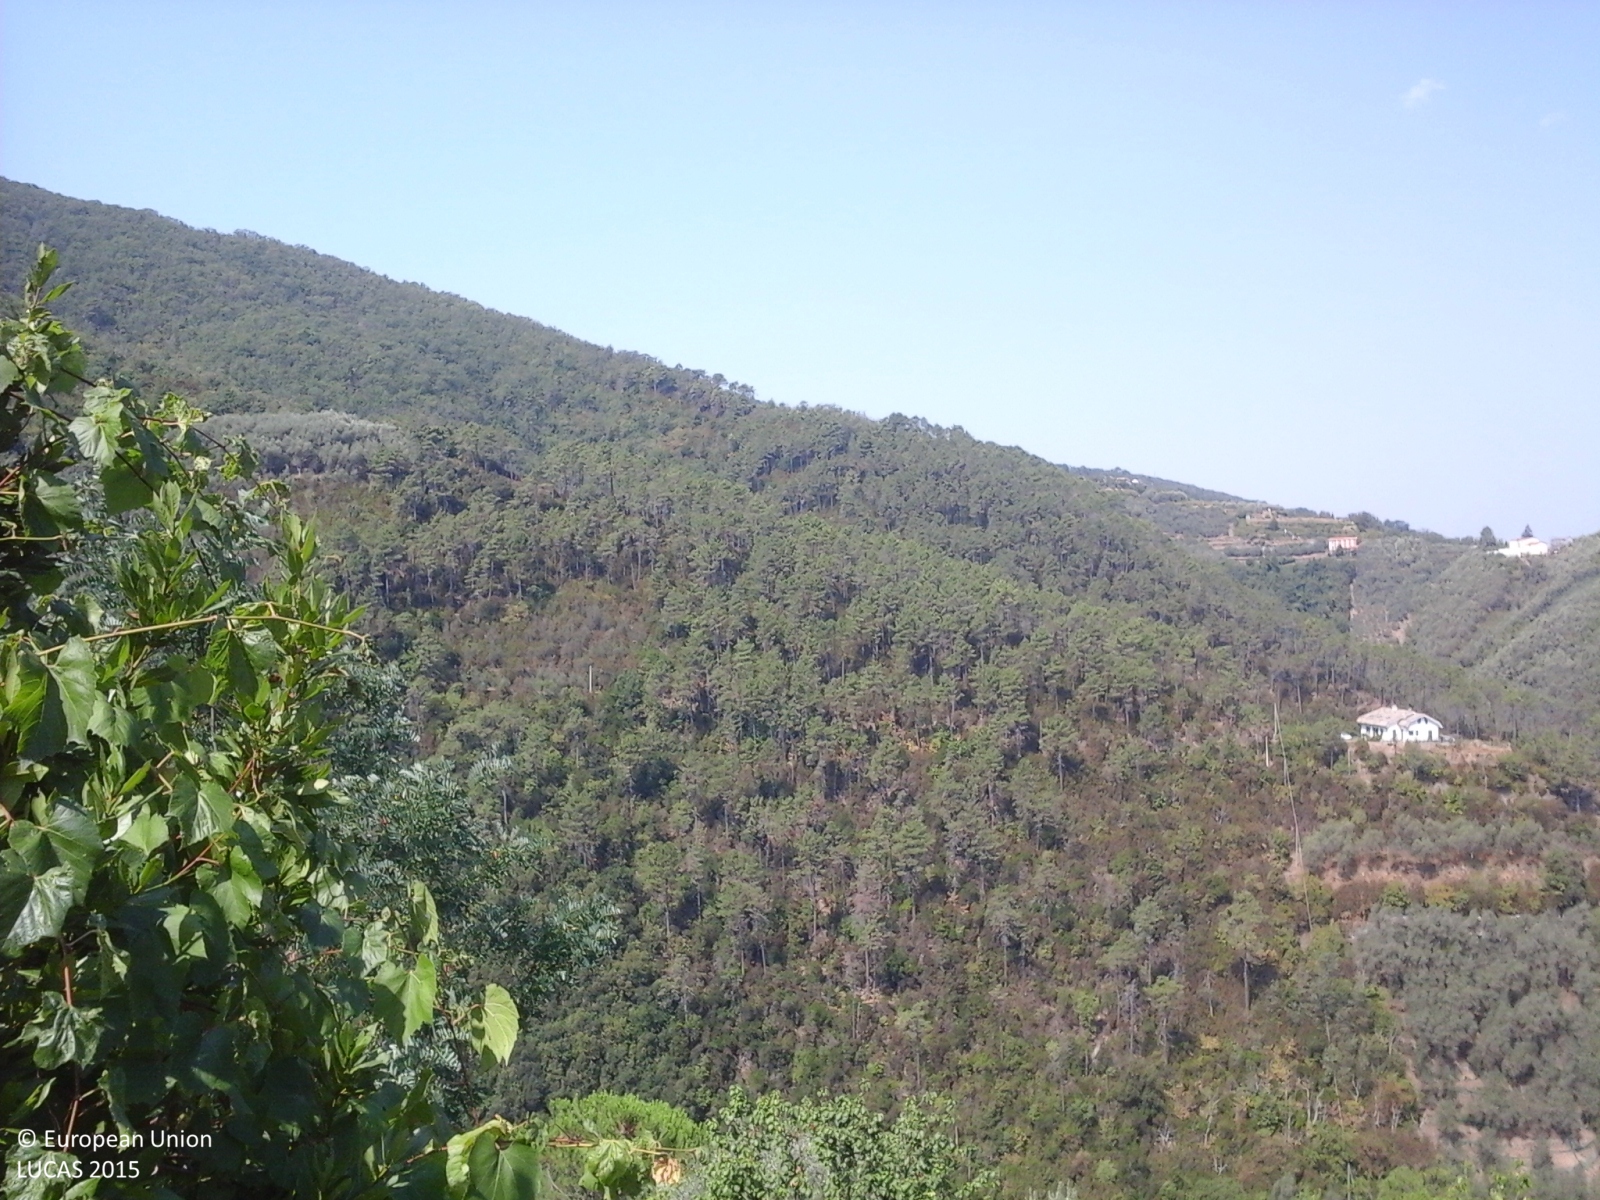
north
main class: Cropland
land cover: Olive groves
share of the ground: > 75 %
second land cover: Grassland without tree/shrub cover
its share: > 75 %
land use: Agriculture (excluding fallow land and kitchen gardens)
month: August
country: IT
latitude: 44.3308
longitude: 9.4120
